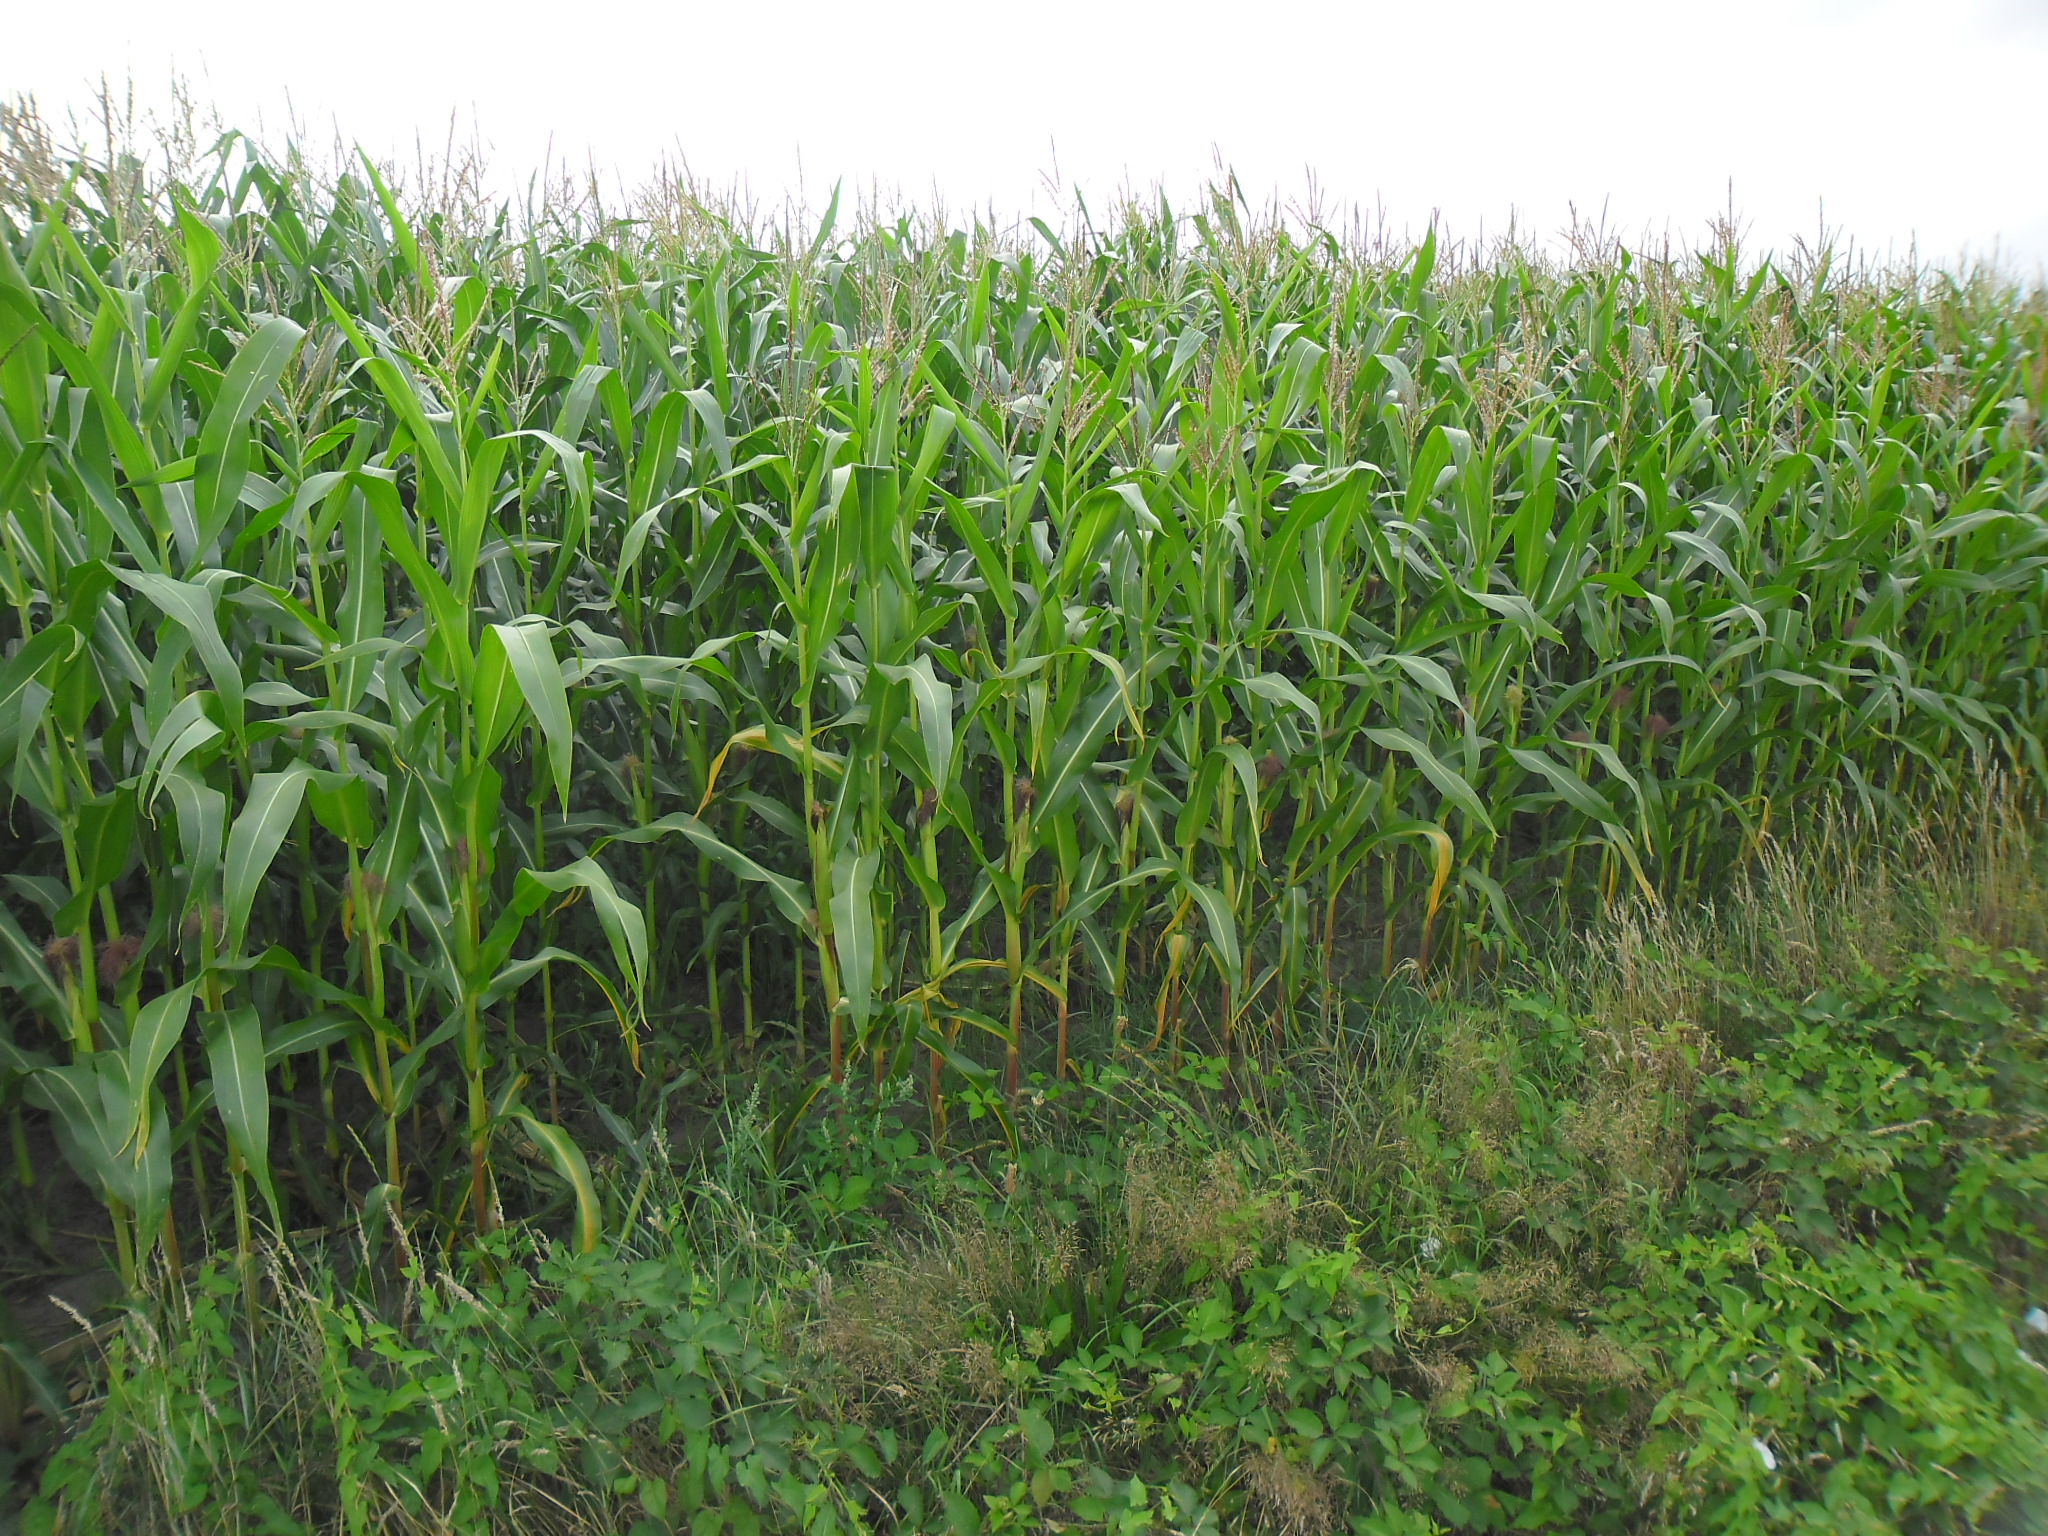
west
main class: Cropland
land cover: Maize
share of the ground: > 75 %
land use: Agriculture (excluding fallow land and kitchen gardens)
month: August
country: NL
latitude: 52.8895
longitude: 5.5845
